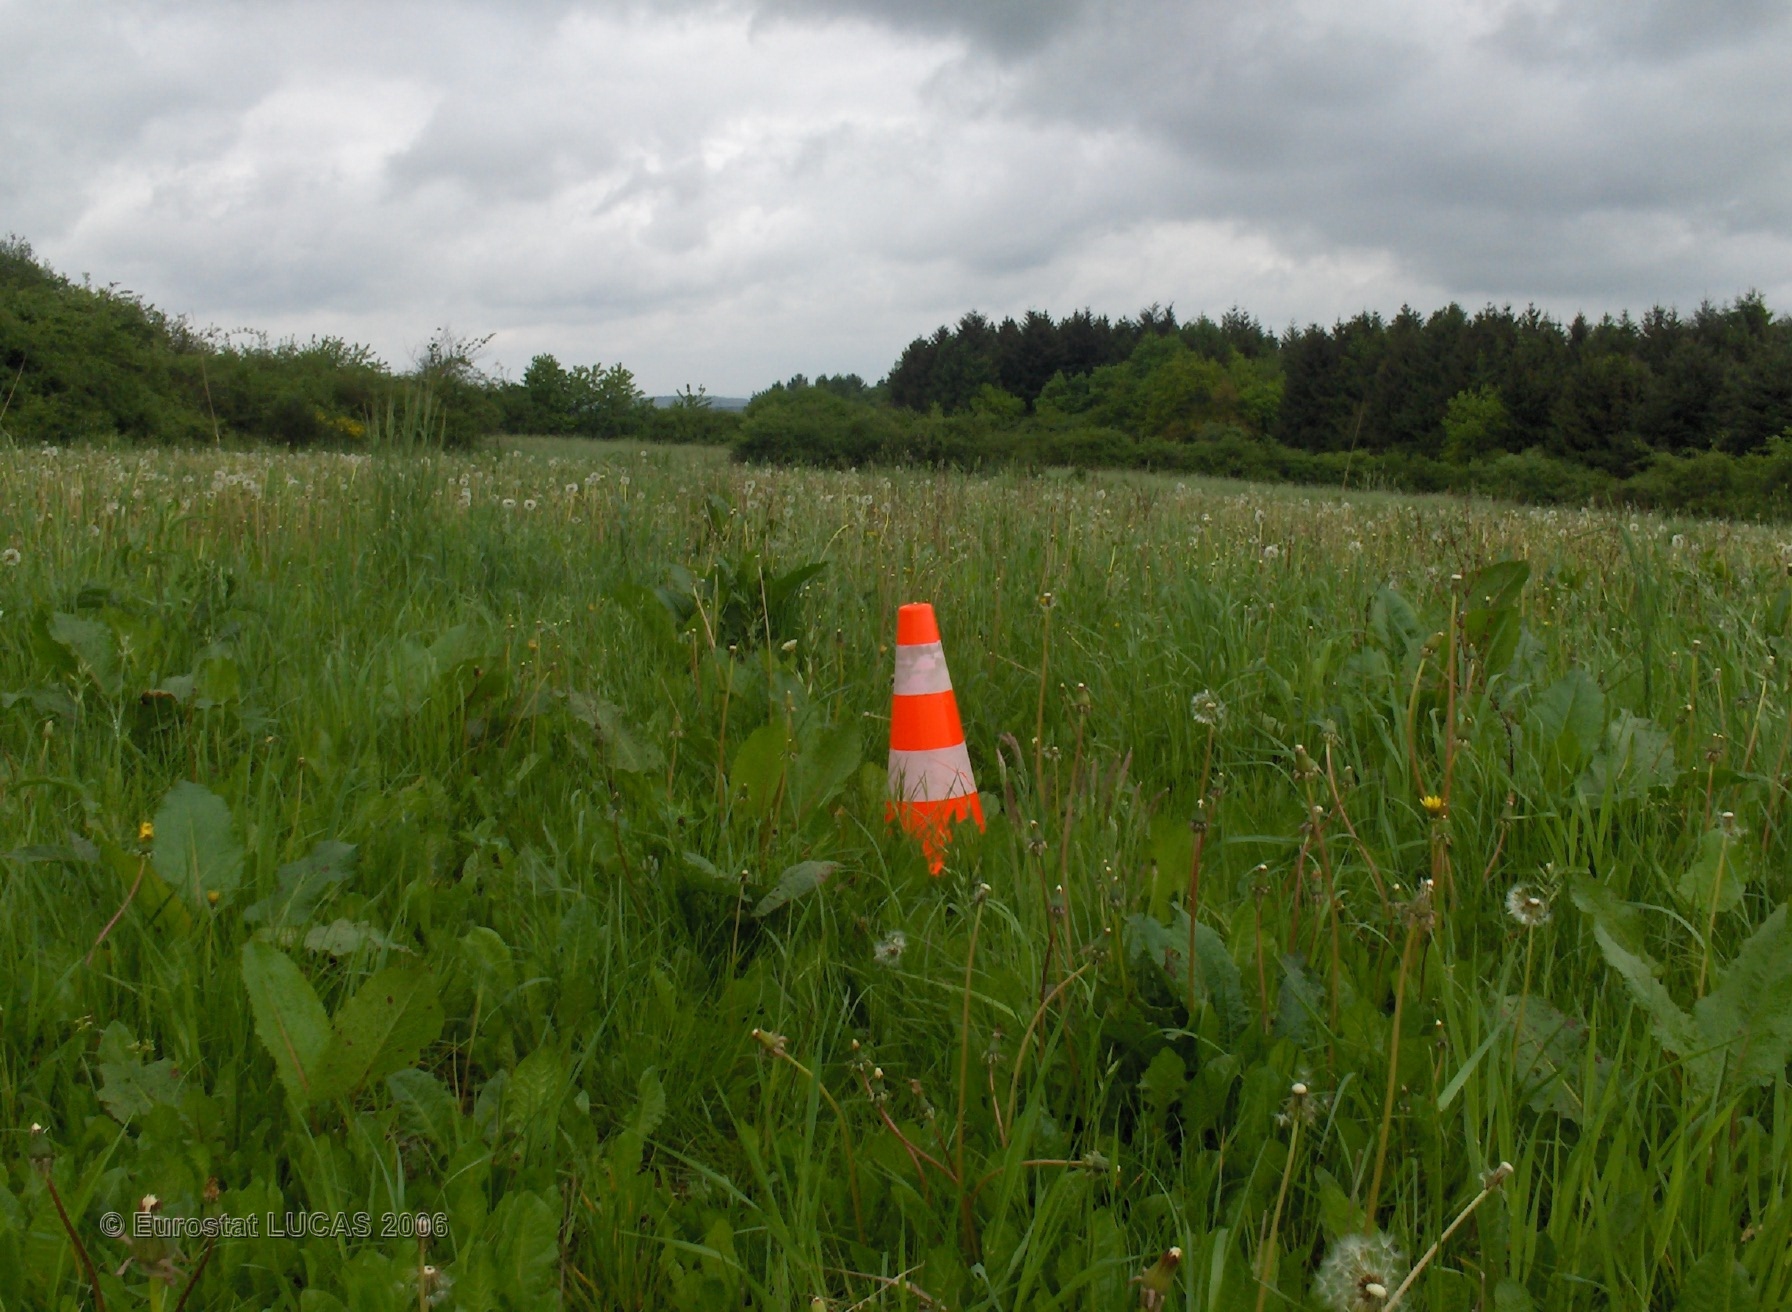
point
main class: Grassland
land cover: Grassland without tree/shrub cover
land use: Agriculture (excluding fallow land and kitchen gardens)
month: May
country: BE
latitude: 50.2663
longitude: 5.2700
